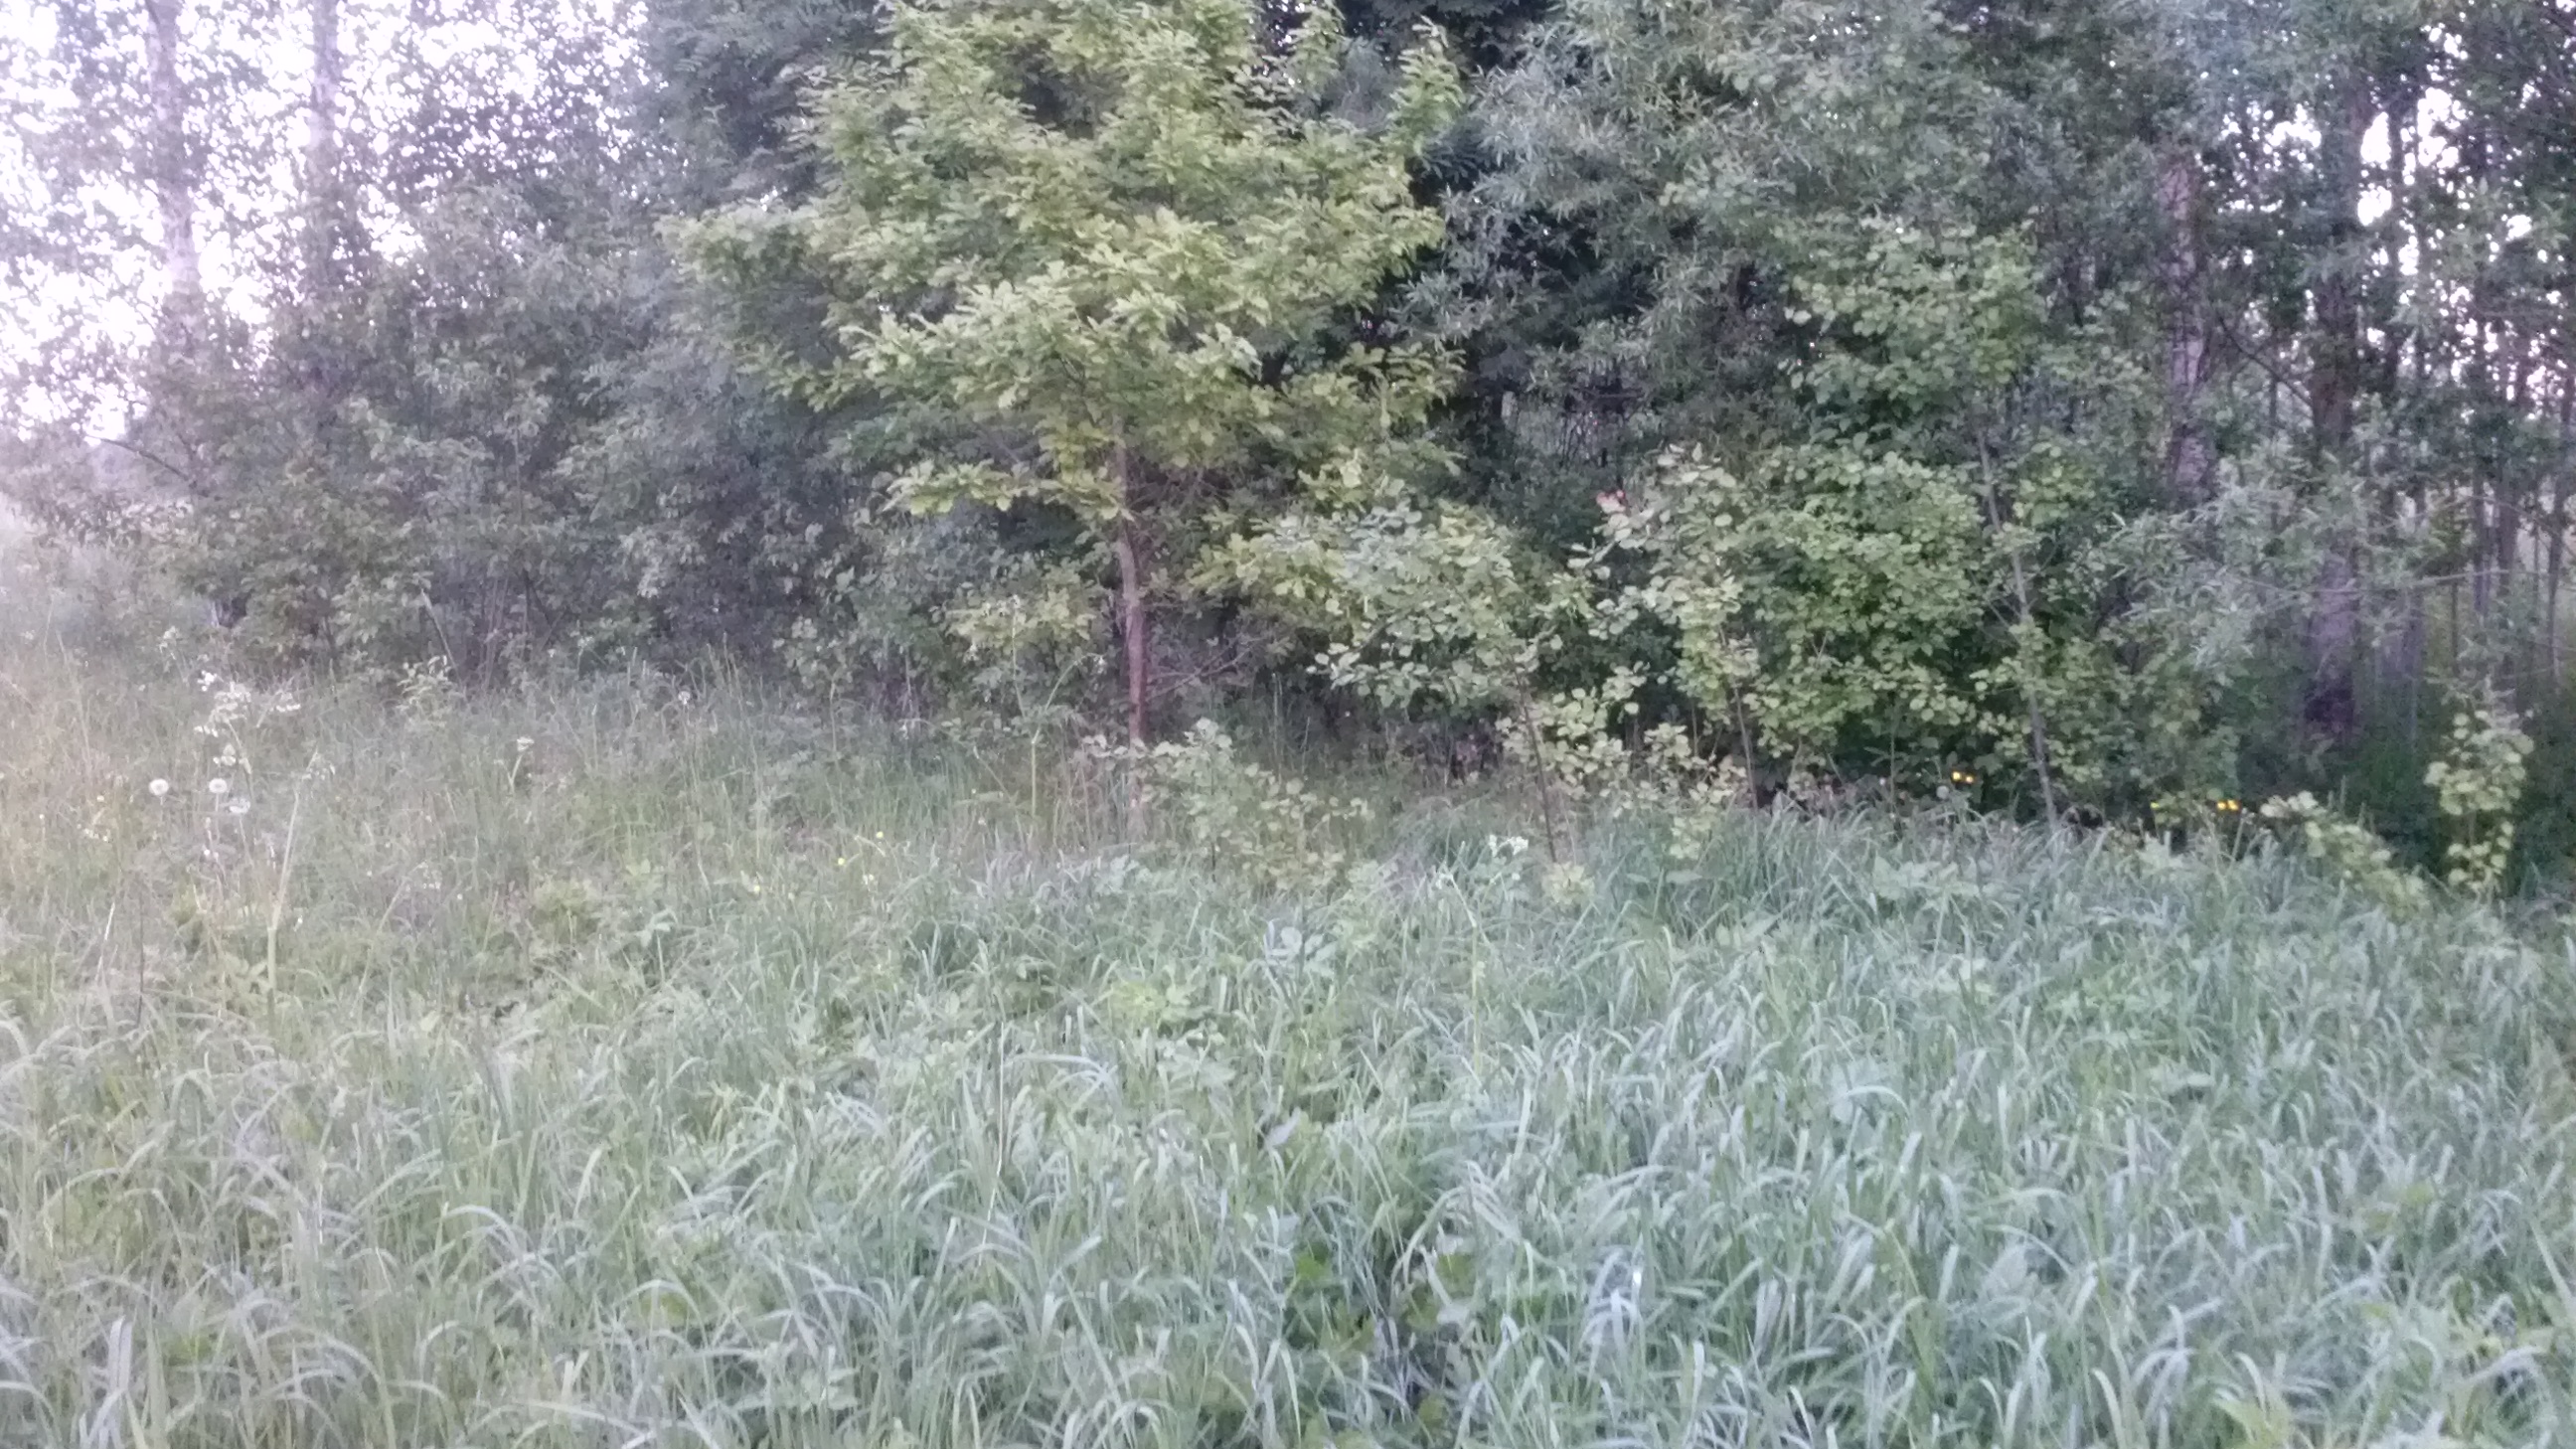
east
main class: Woodland
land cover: Broadleaved woodland
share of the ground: 25 - 50 %
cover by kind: herbaceous plants 50 %, broadleaved forest trees 40 %, shrubs 10 %
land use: Semi-natural and natural areas not in use
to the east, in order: Broadleaved woodland; Spontaneously vegetated surfaces; Broadleaved woodland; Spontaneously vegetated surfaces; Broadleaved woodland; Grassland without tree/shrub cover; Electric lines; Grassland without tree/shrub cover; Paved roads, cycling and walking lanes
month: June
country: LV
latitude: 56.3825
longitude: 27.9619
